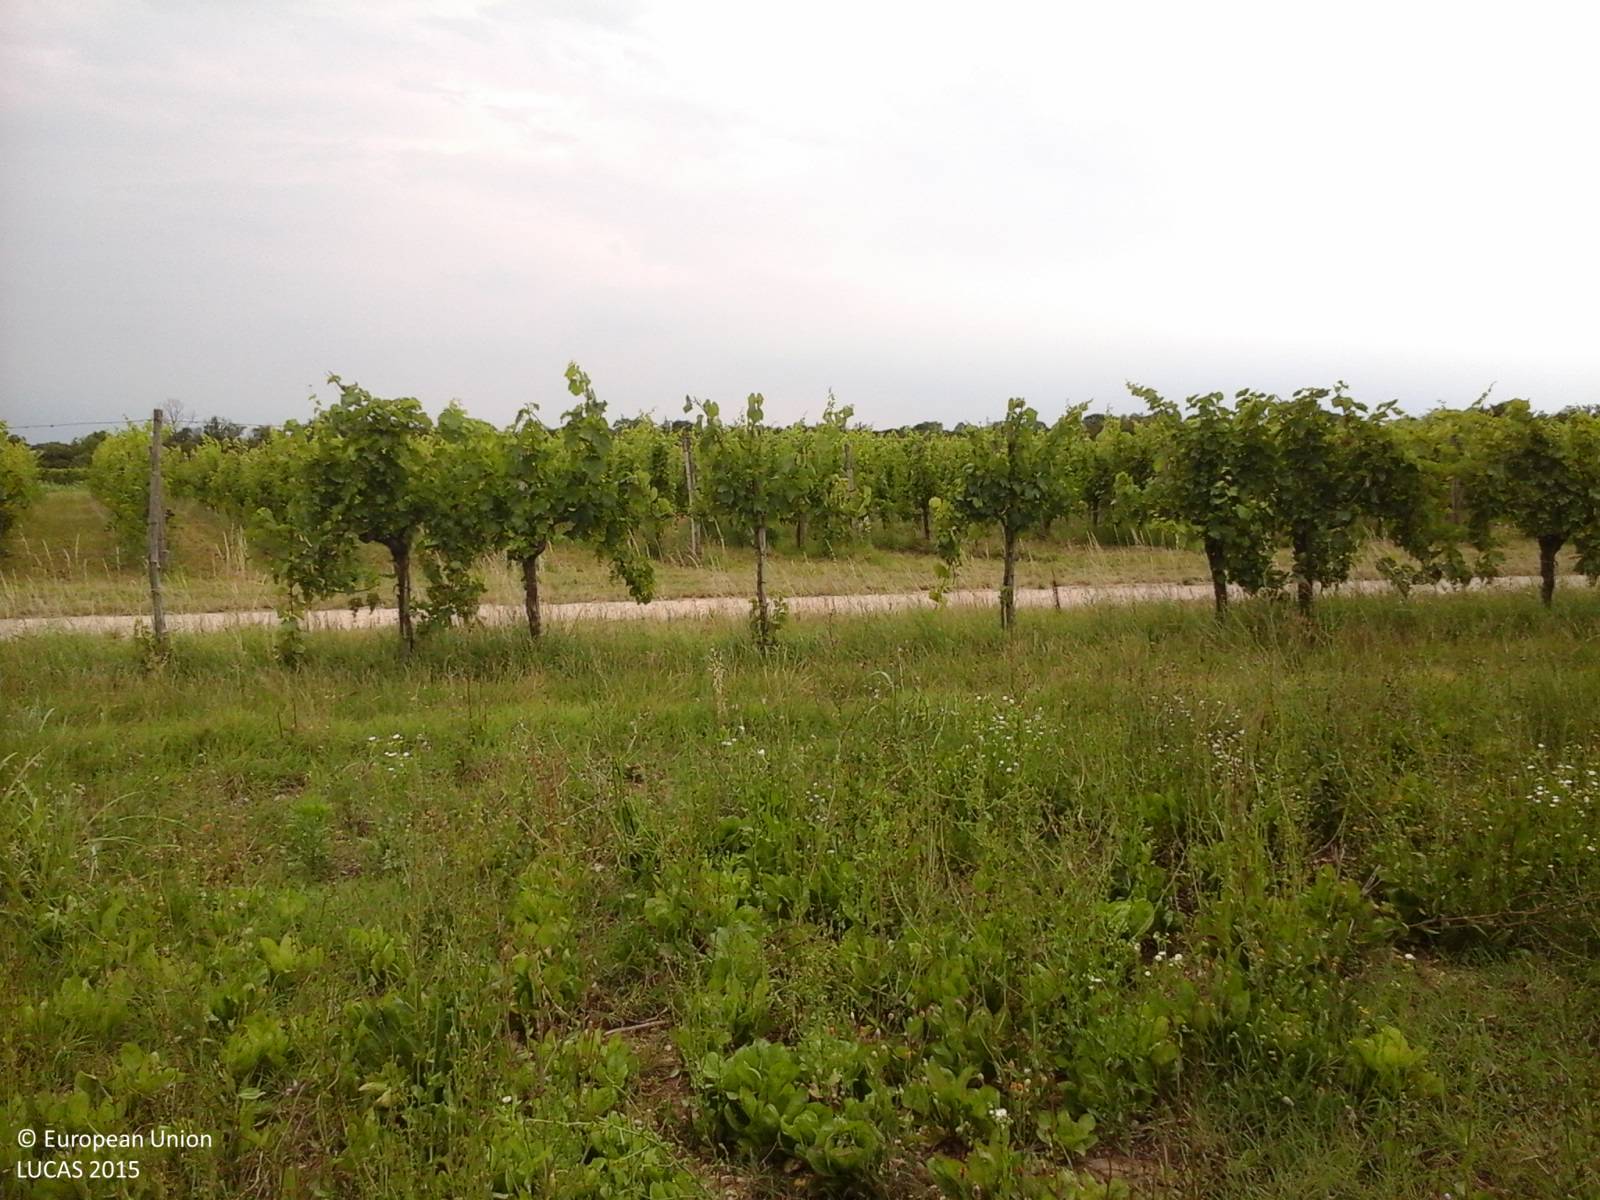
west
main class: Grassland
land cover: Spontaneously vegetated surfaces
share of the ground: > 75 %
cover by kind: herbaceous plants 100 %
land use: Fallow land
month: June
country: IT
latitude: 45.9713
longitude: 13.4420
